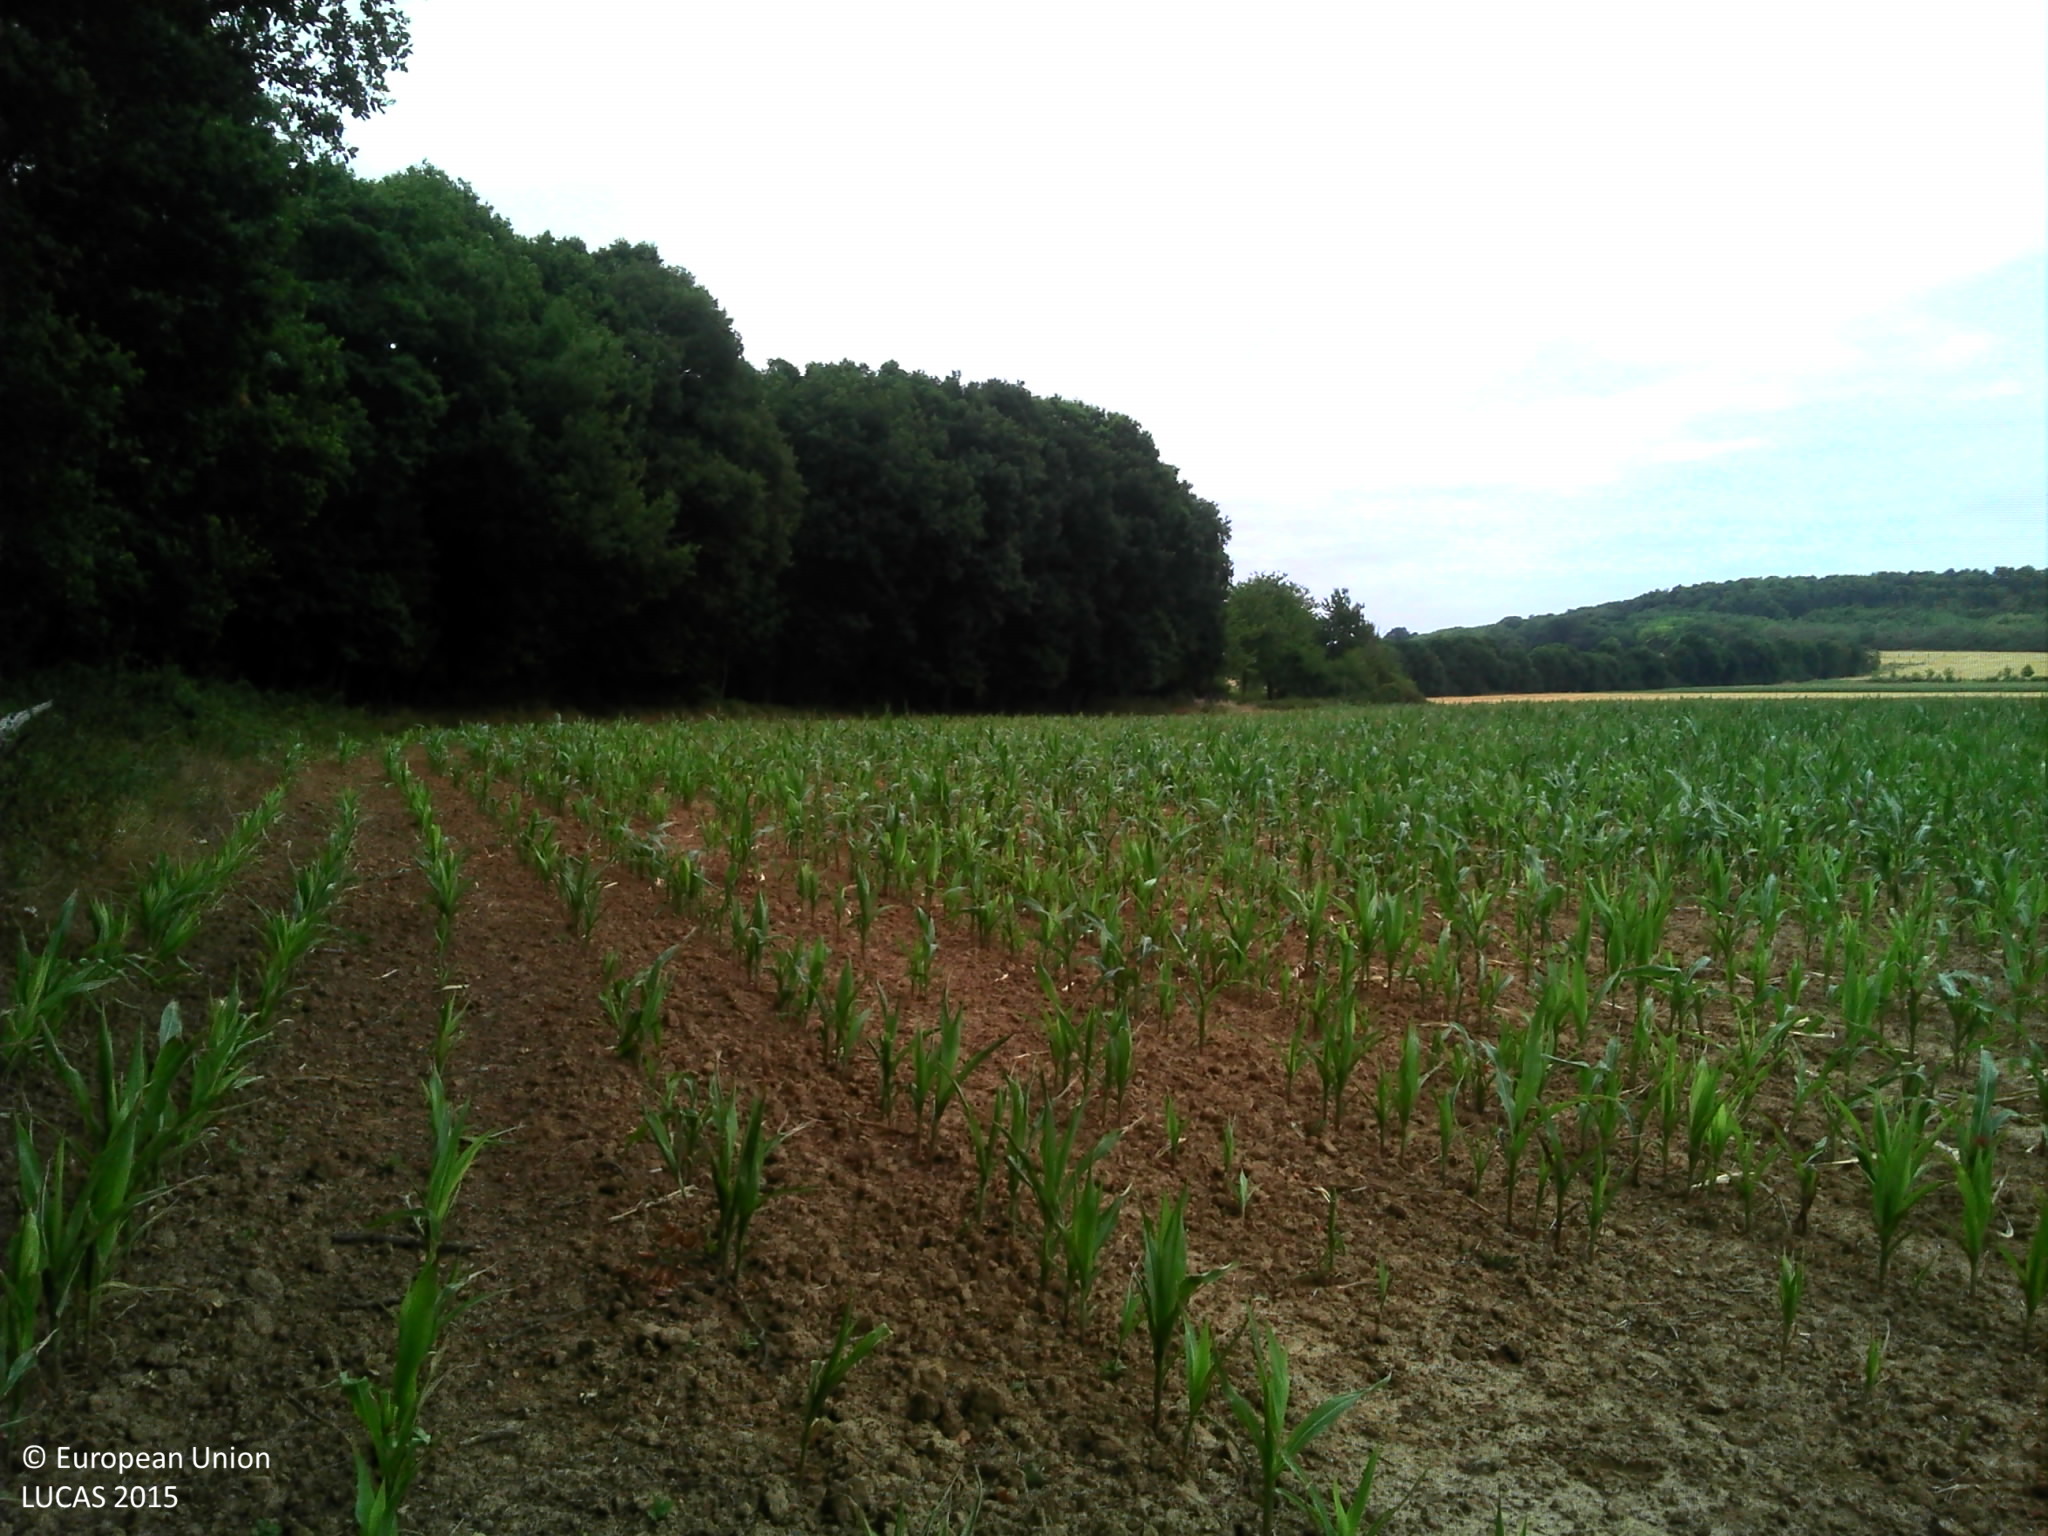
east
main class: Cropland
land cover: Maize
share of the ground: 10 - 25 %
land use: Agriculture (excluding fallow land and kitchen gardens)
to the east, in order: Maize; Durum wheat
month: July
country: FR
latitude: 48.4387
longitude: 2.5144
